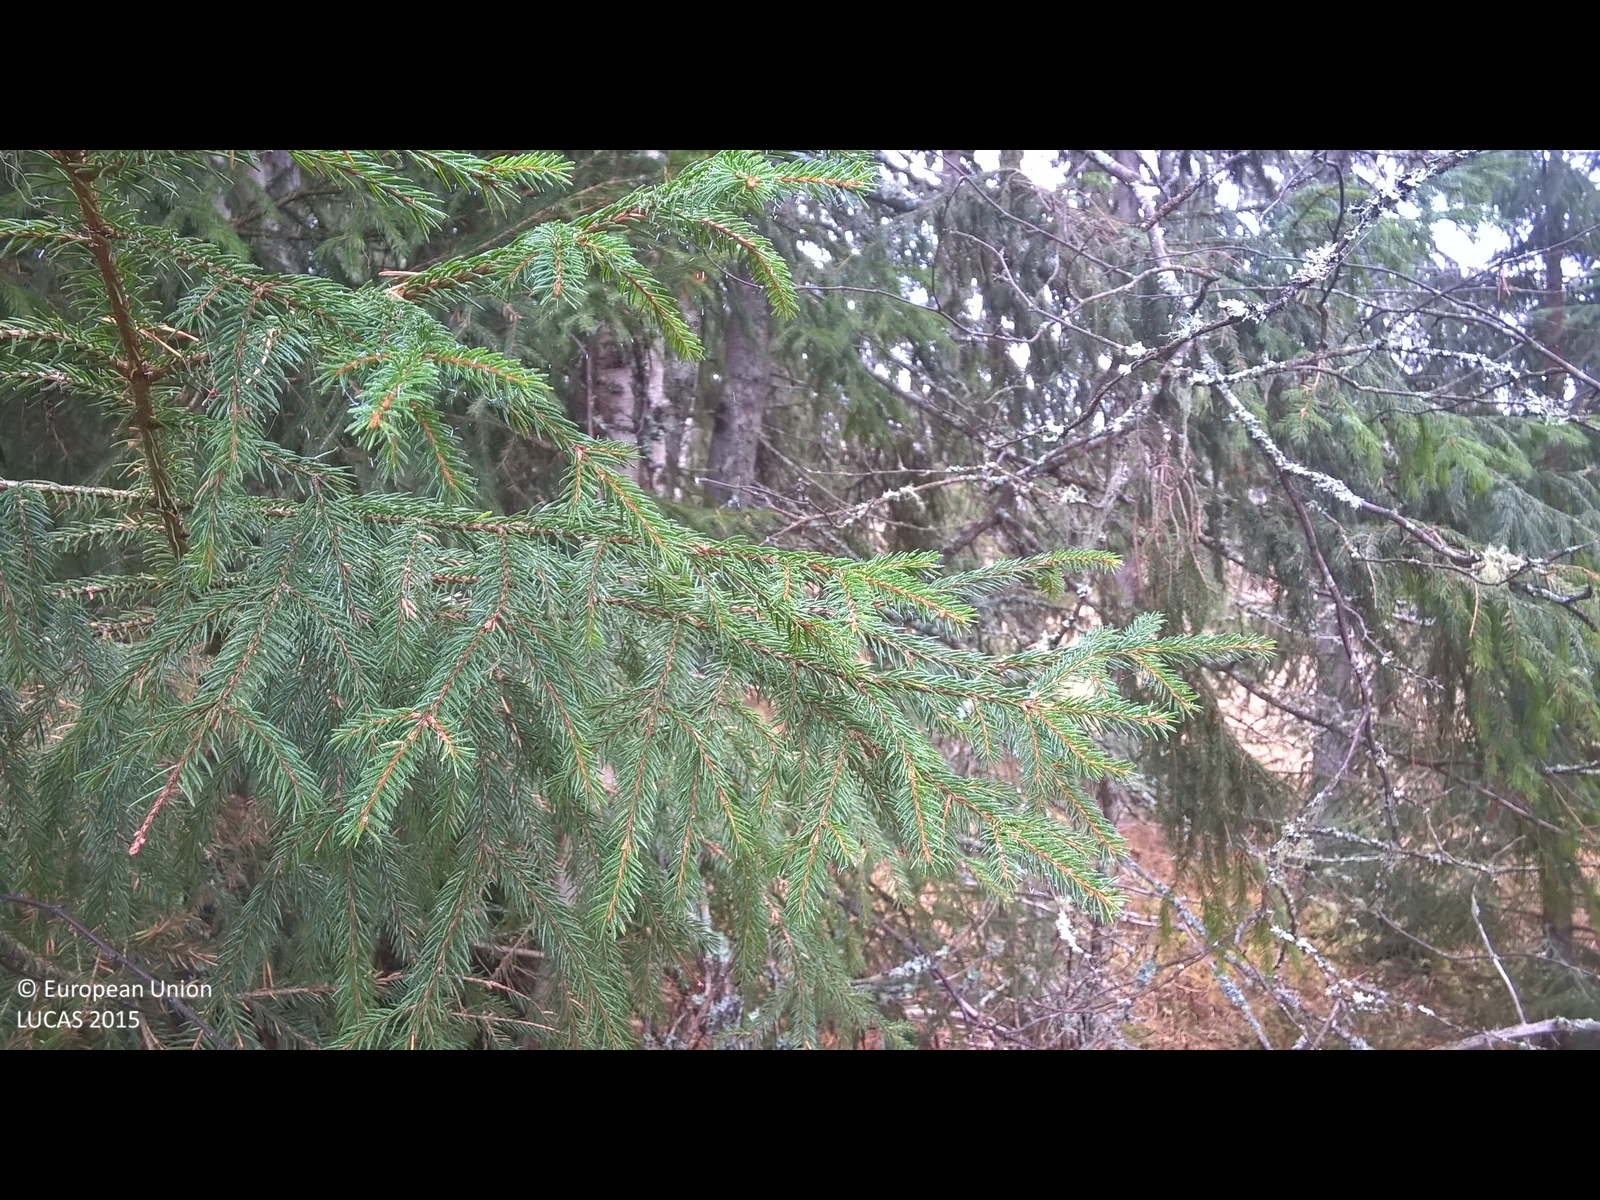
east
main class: Woodland
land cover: Spruce dominated mixed woodland
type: boreal forest
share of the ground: 25 - 50 %
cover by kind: lichens and mosses 40 %, coniferous forest trees 30 %, broadleaved forest trees 15 %, herbaceous plants 10 %, shrubs 5 %
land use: Forestry
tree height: > 5 m
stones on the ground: < 10 %
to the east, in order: Spruce dominated mixed woodland; Grassland with sparse tree/shrub cover; Artificial constructions in urban areas; Spruce dominated mixed woodland
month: October
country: SE
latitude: 62.9576
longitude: 15.1634
